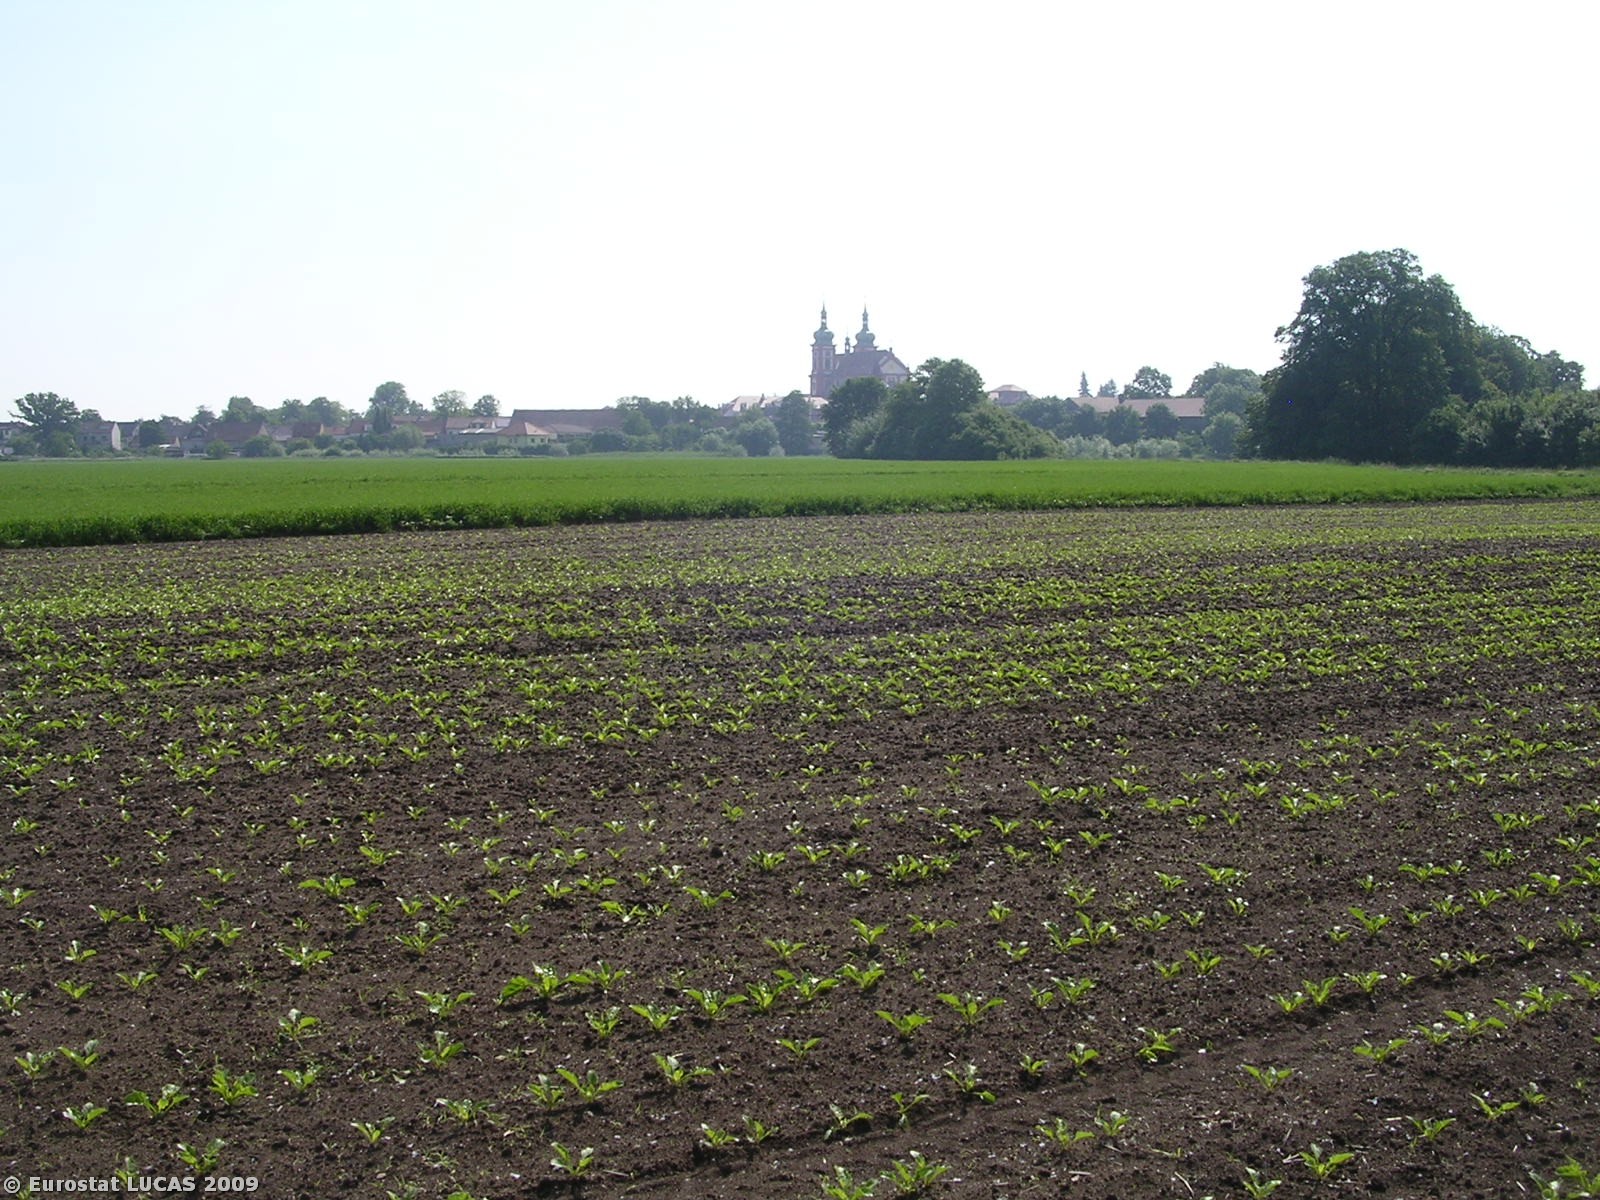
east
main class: Cropland
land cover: Sugar beet
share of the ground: 25 - 50 %
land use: Agriculture (excluding fallow land and kitchen gardens)
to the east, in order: Sugar beet; Common wheat
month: May
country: CZ
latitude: 50.1968
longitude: 14.6669
